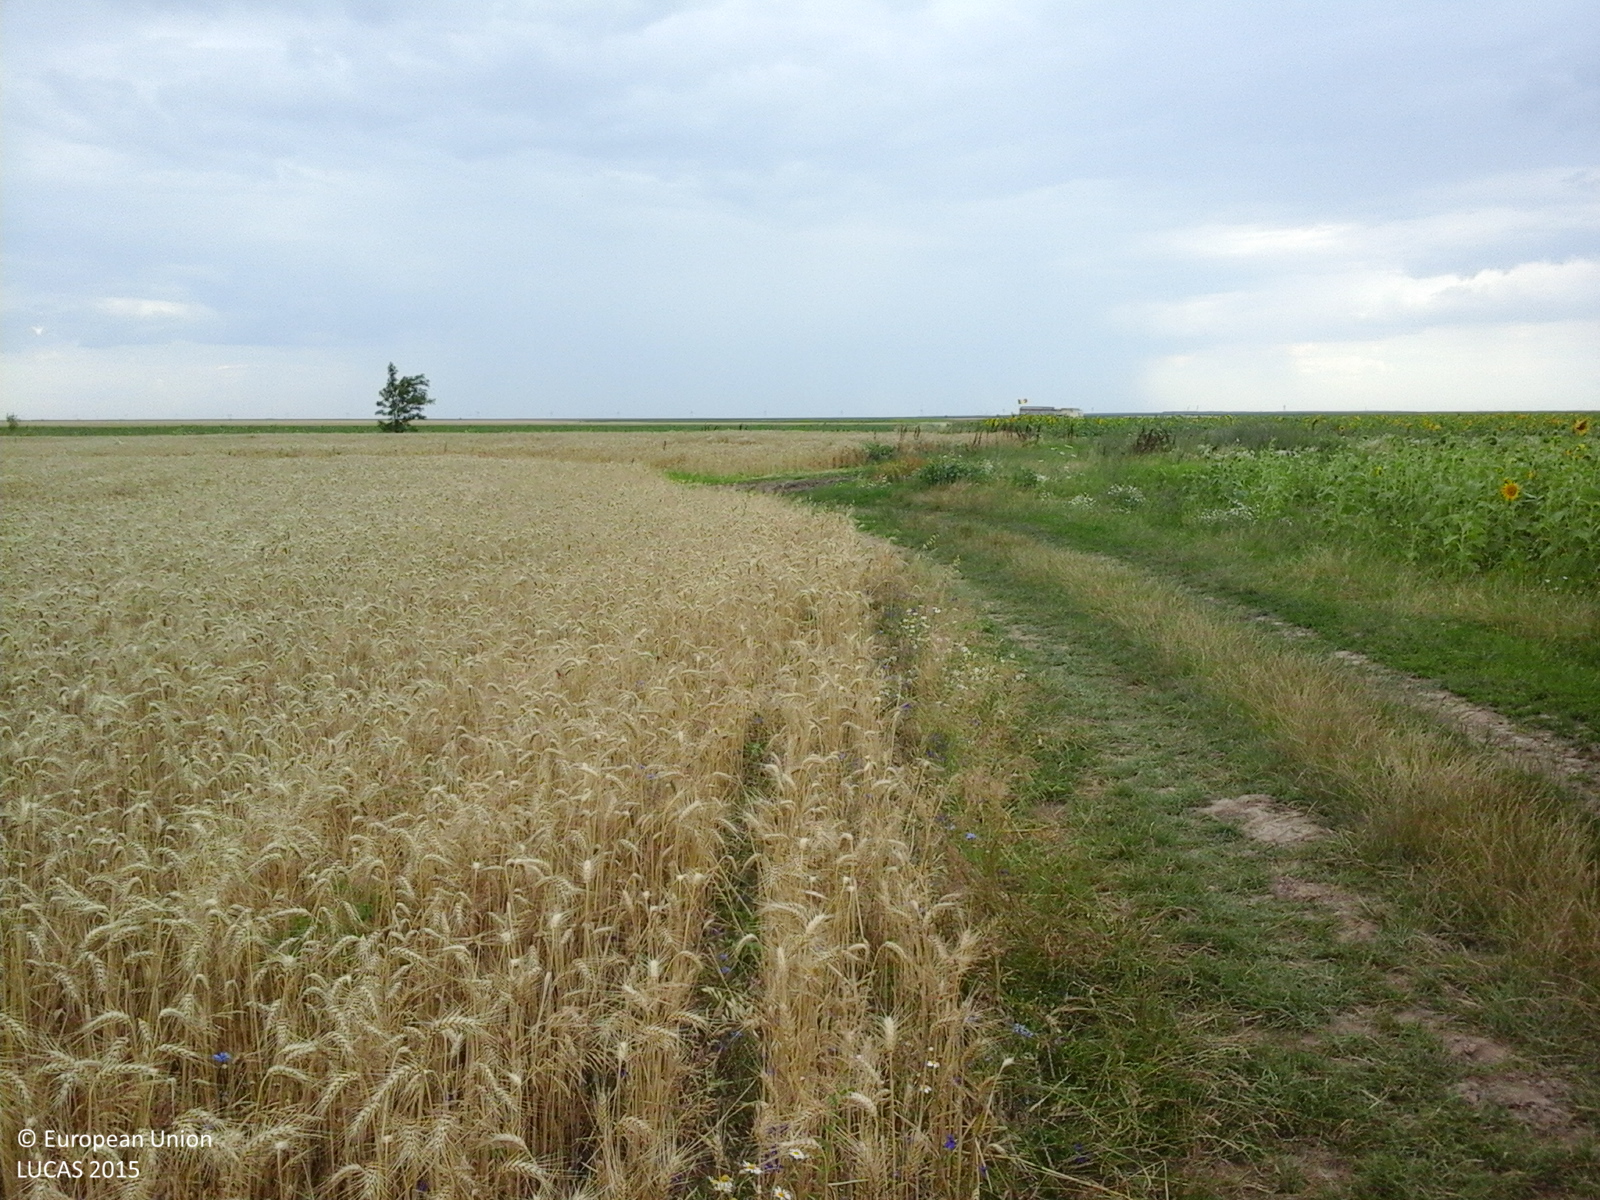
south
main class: Cropland
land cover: Common wheat
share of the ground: > 75 %
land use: Agriculture (excluding fallow land and kitchen gardens)
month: July
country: RO
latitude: 44.3600
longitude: 24.8188
